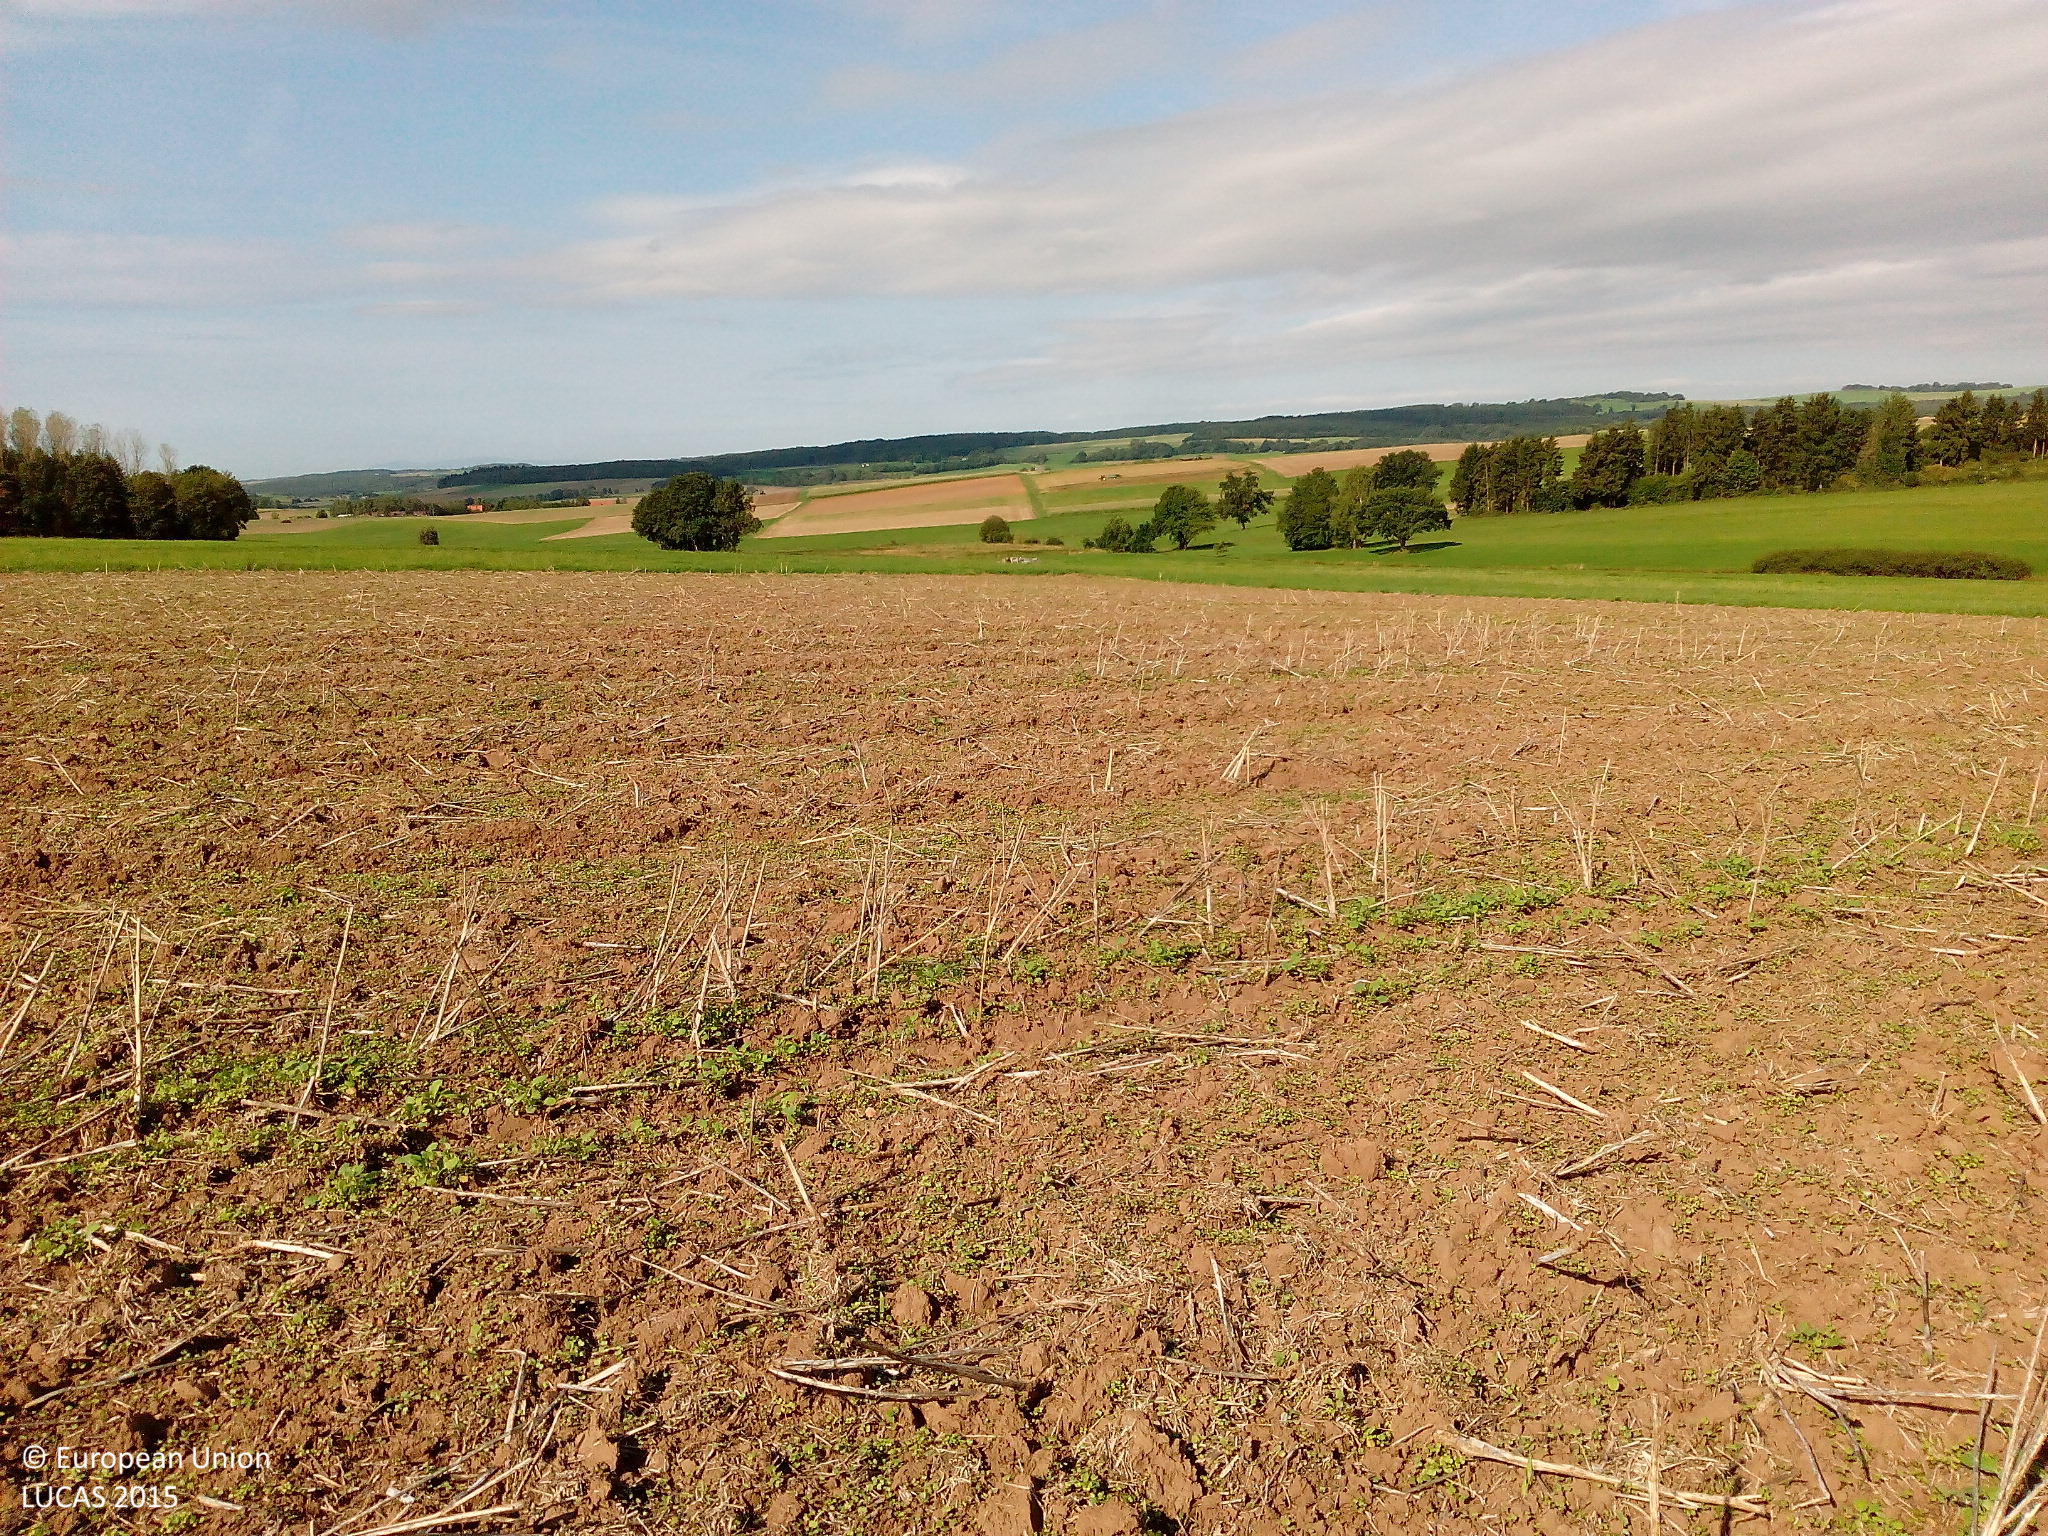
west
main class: Cropland
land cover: Rape and turnip rape
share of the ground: 10 - 25 %
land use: Agriculture (excluding fallow land and kitchen gardens)
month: August
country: DE
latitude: 50.3979
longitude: 9.3109
